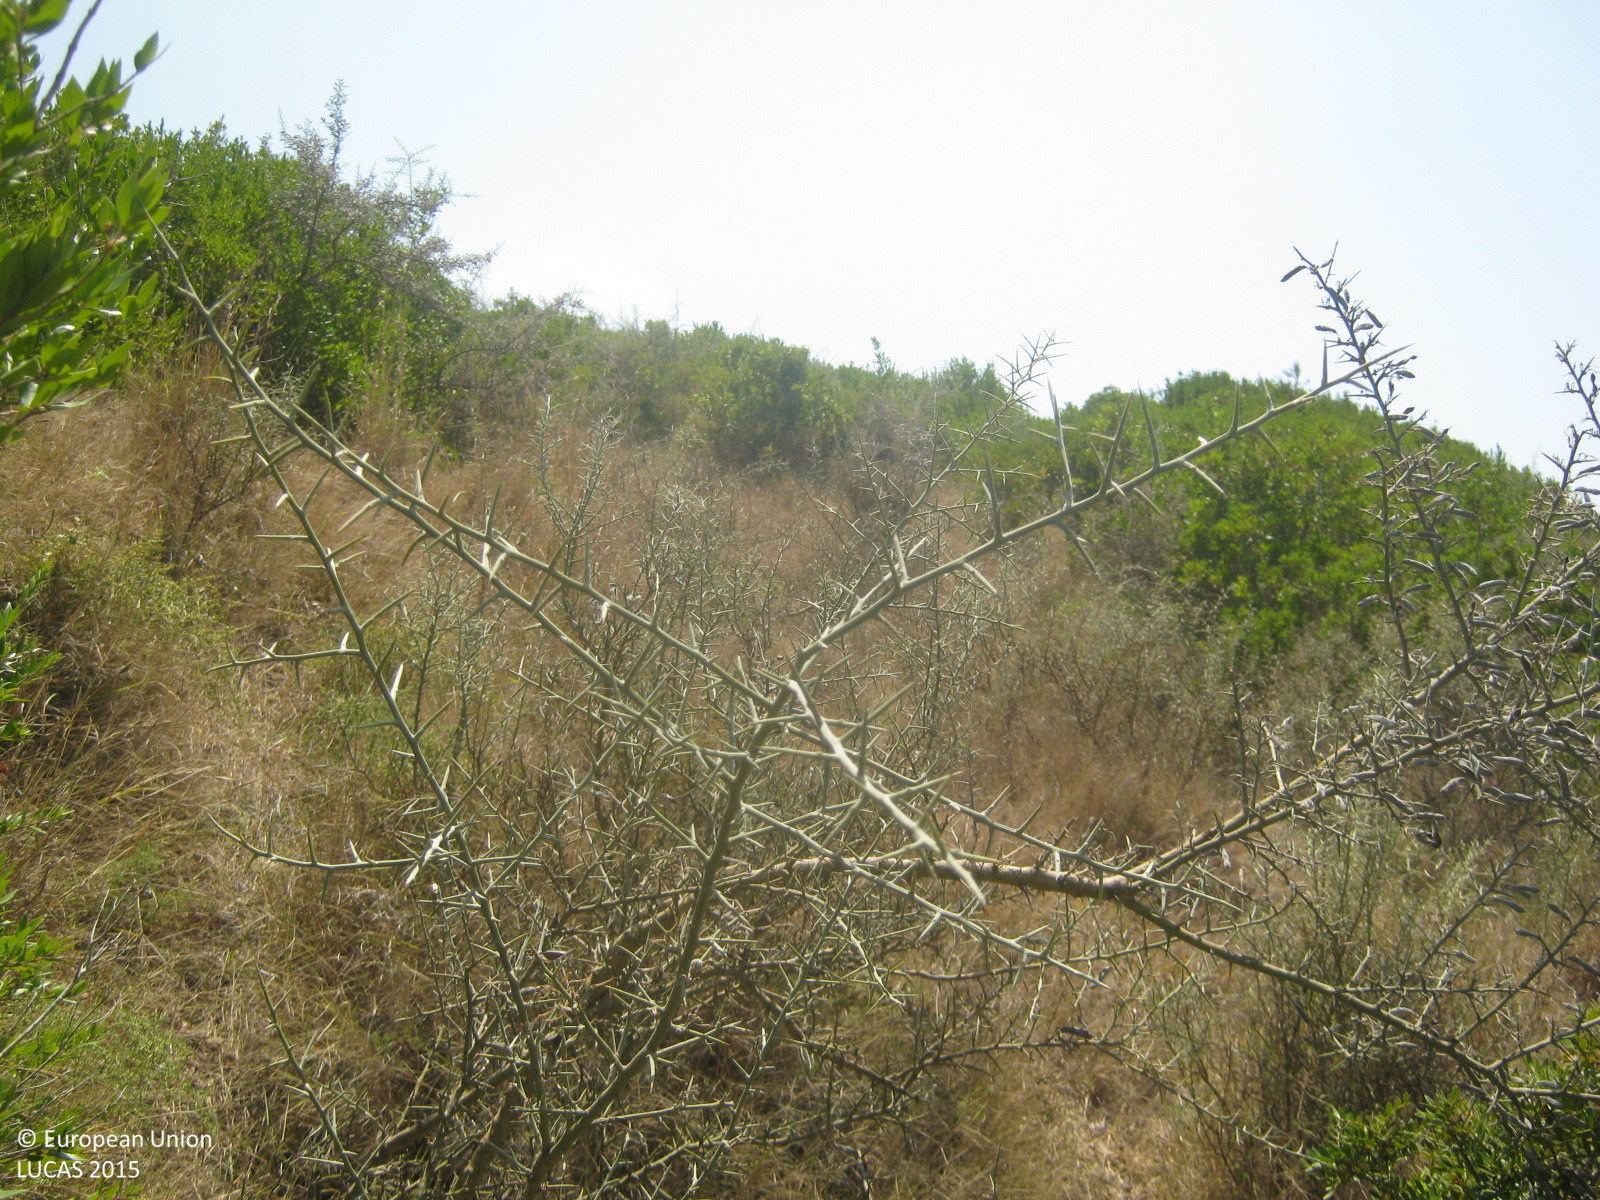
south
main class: Shrubland
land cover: Shrubland without tree cover
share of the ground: > 75 %
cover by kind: shrubs 80 %, herbaceous plants 20 %
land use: Semi-natural and natural areas not in use
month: August
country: GR
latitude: 38.3005
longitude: 20.4707
